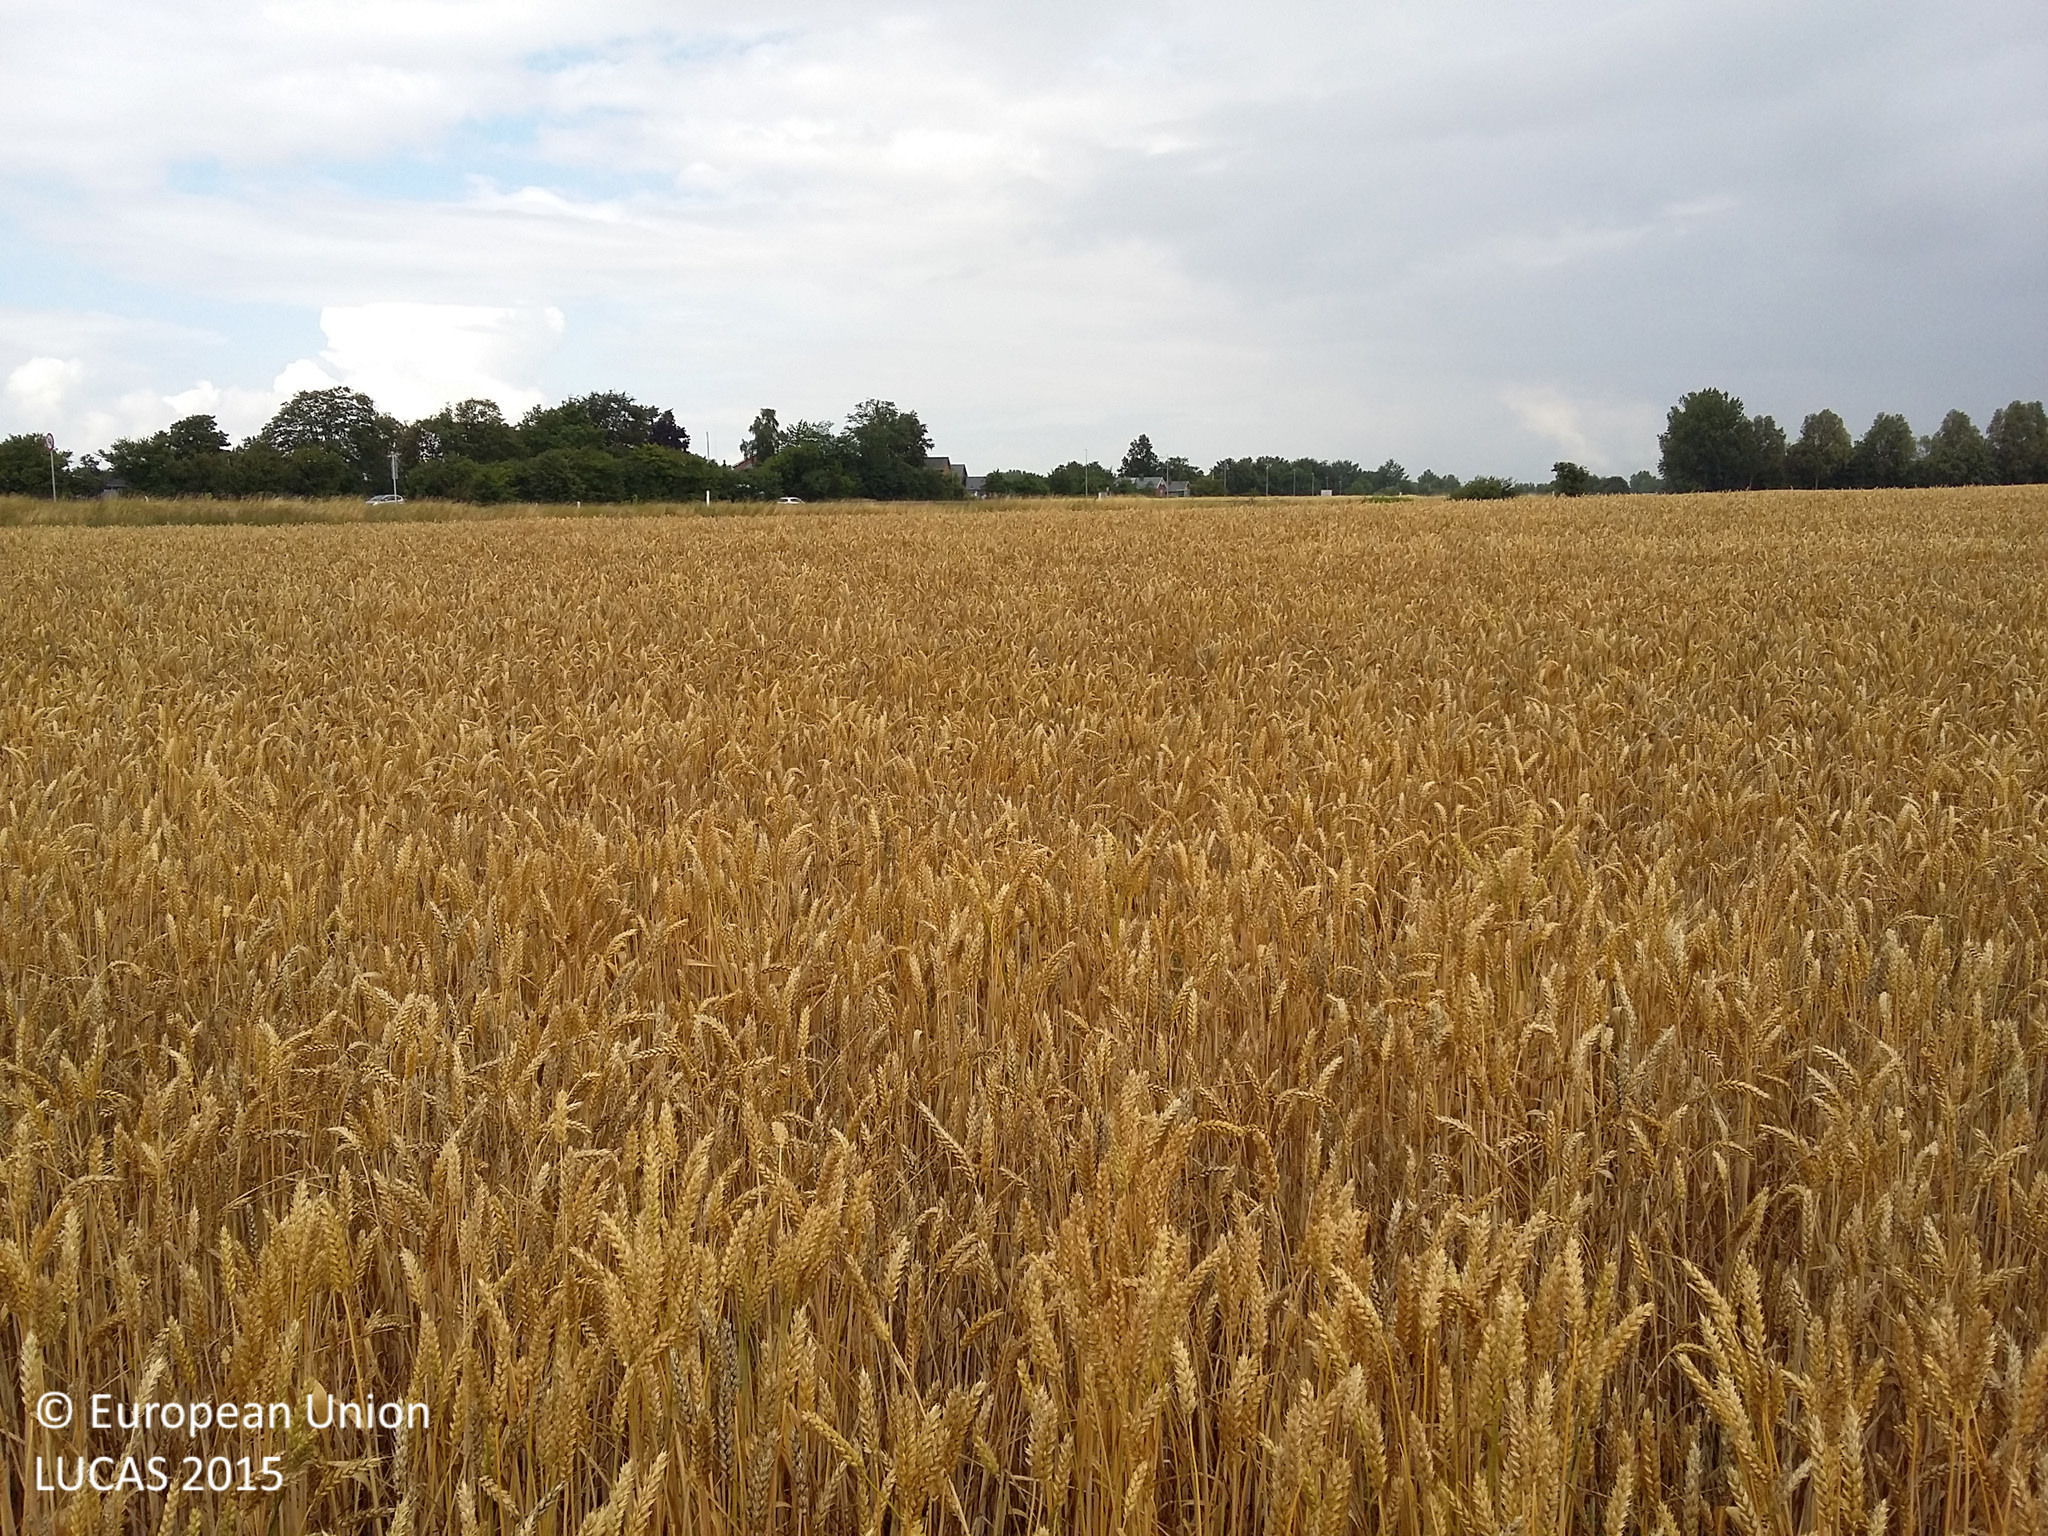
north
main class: Cropland
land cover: Common wheat
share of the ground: > 75 %
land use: Agriculture (excluding fallow land and kitchen gardens)
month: July
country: DK
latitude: 55.7741
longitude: 12.1502
